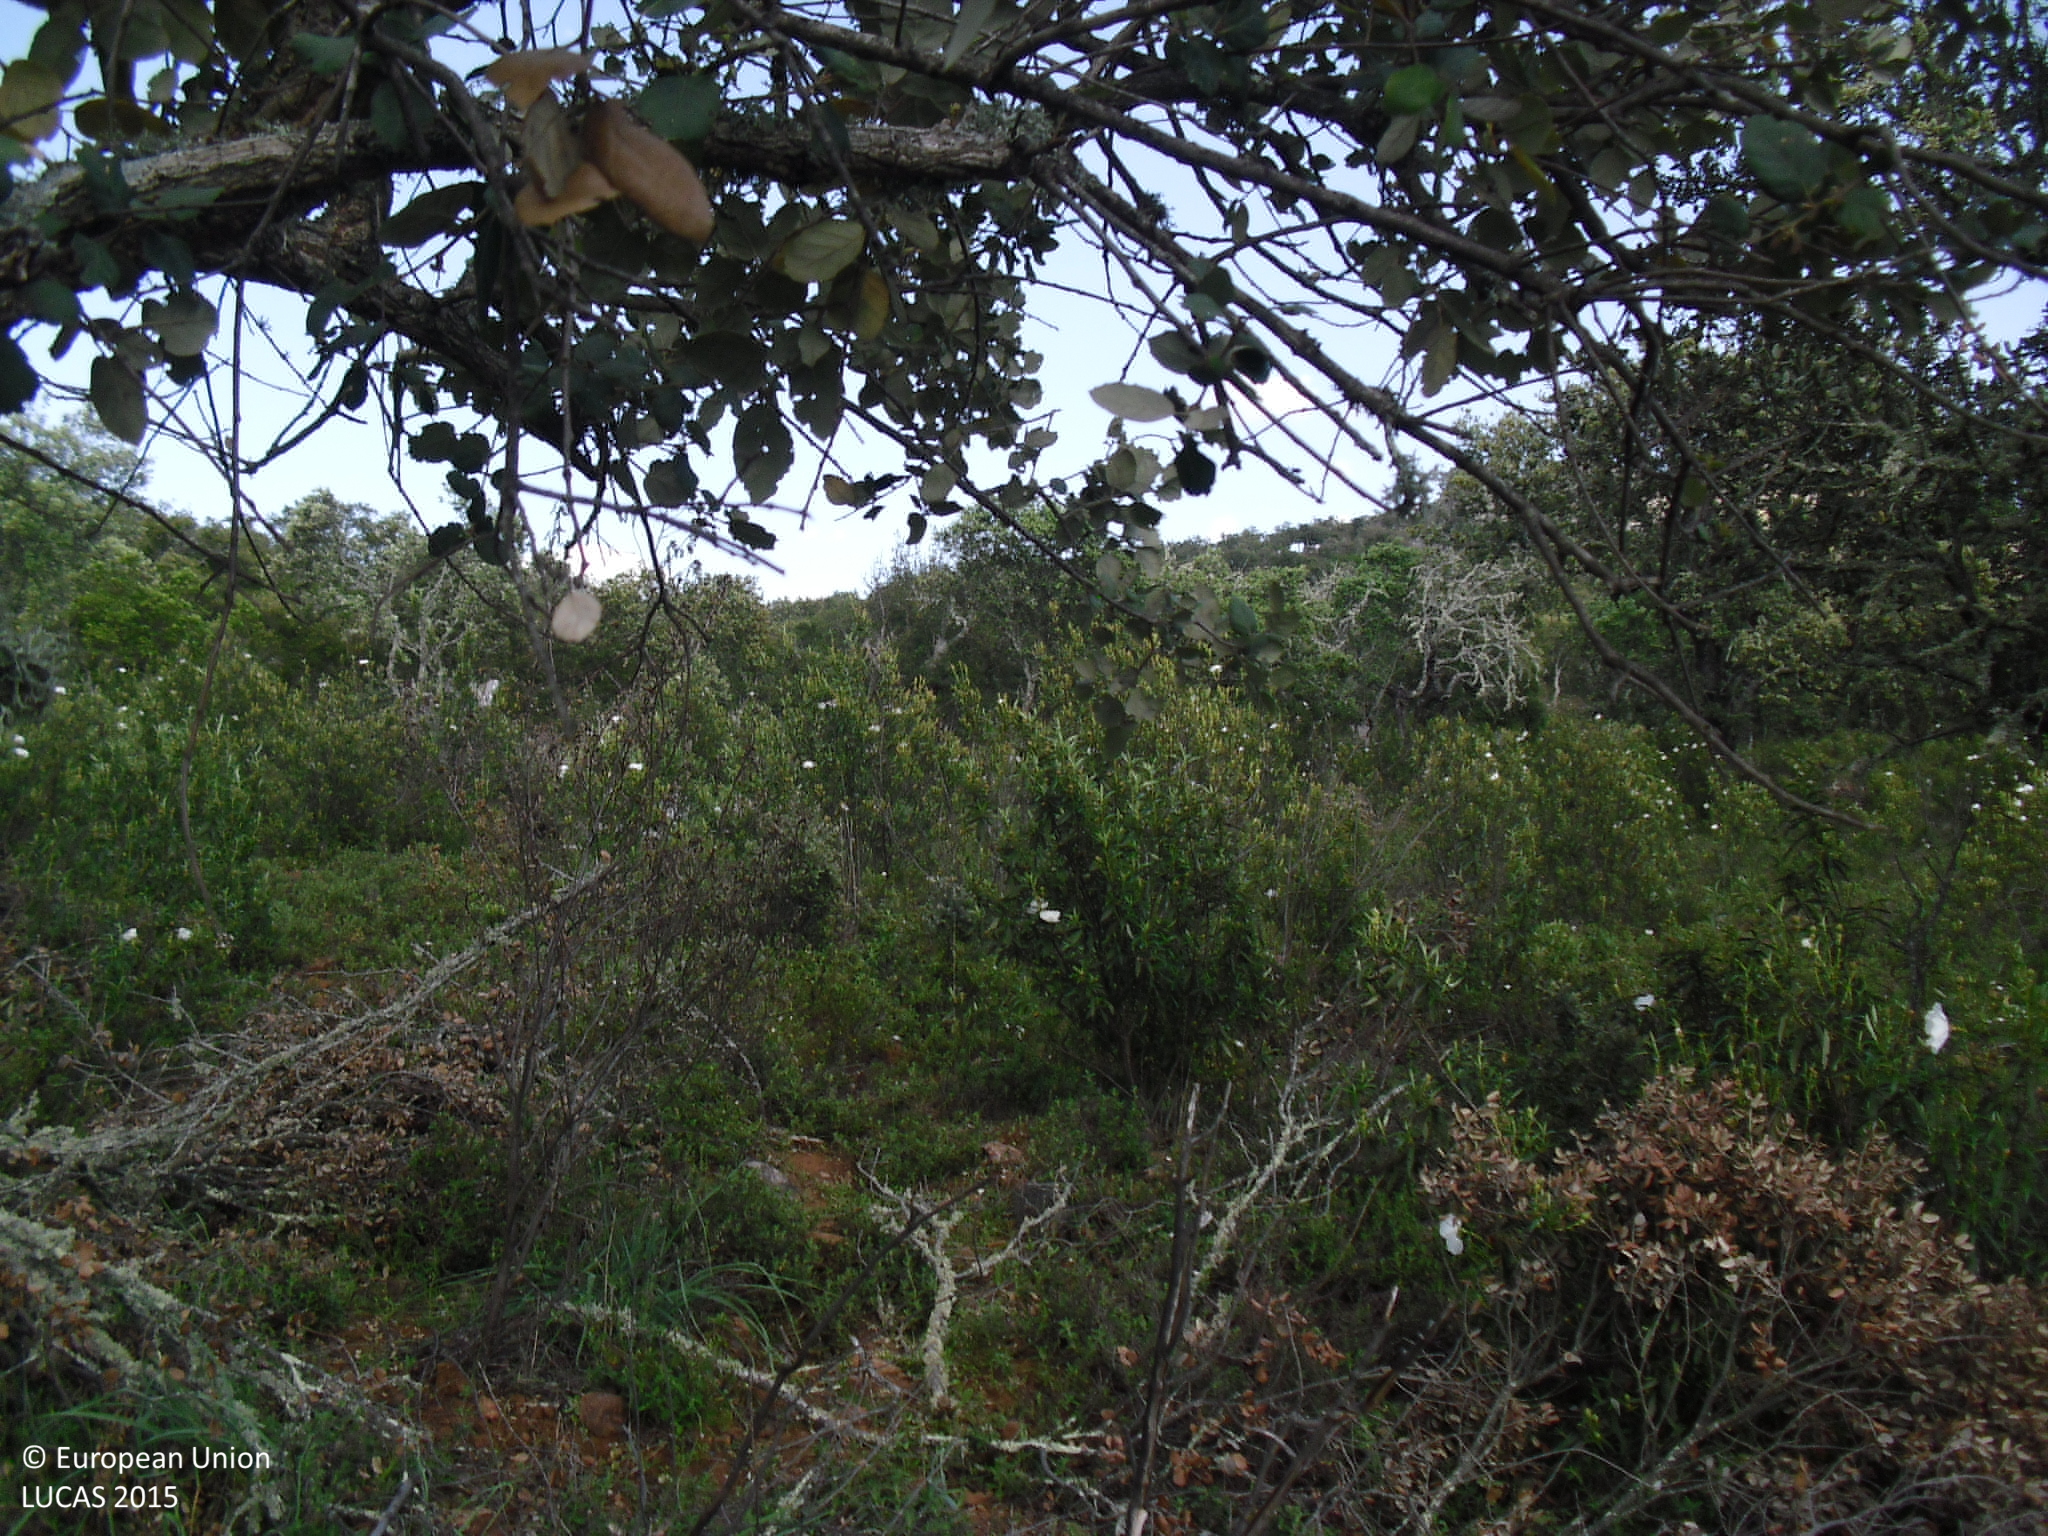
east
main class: Woodland
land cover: Broadleaved woodland
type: broadleaved evergreen forest
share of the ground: 10 - 25 %
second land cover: Shrubland without tree cover
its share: 50 - 75 %
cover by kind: shrubs 60 %, herbaceous plants 25 %, broadleaved forest trees 15 %
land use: Forestry
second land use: Agriculture (excluding fallow land and kitchen gardens)
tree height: > 5 m
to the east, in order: Broadleaved woodland; Shrubland without tree cover; Broadleaved woodland; Other structural elements; Broadleaved woodland; Tracks; Broadleaved woodland; Fences; Other structural elements; Broadleaved woodland
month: April
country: ES
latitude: 39.3840
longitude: -6.6626
